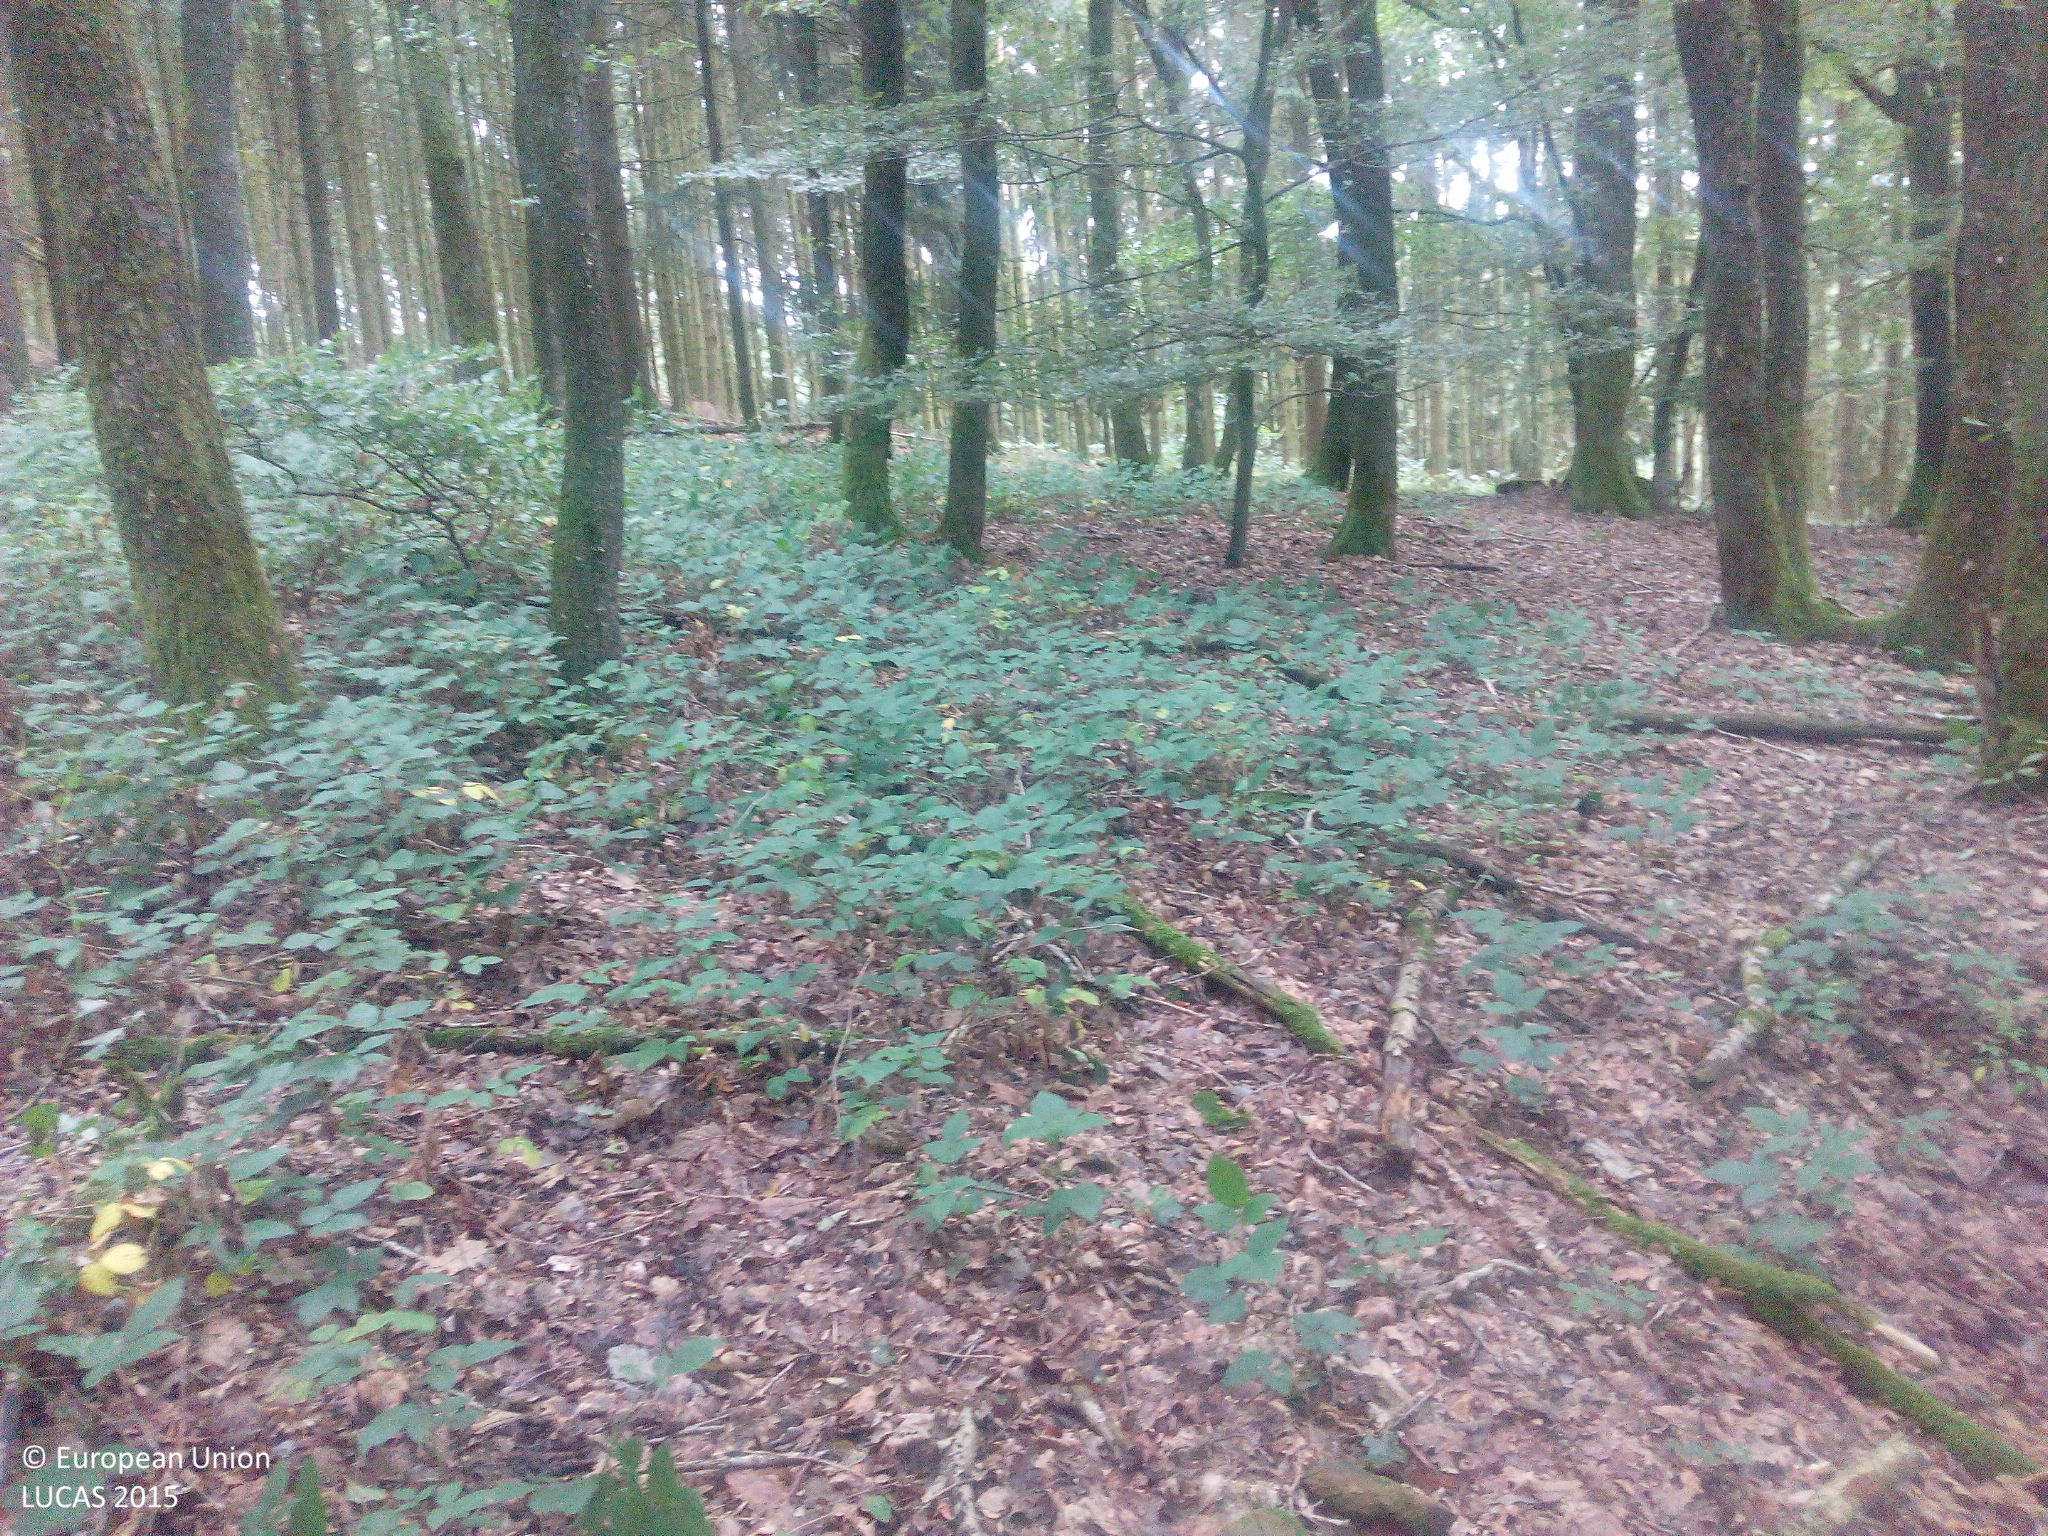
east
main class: Woodland
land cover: Broadleaved woodland
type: mesophytic deciduous forest
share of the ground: > 75 %
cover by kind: broadleaved forest trees 100 %
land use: Forestry
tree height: > 5 m
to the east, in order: Broadleaved woodland; Tracks; Spruce dominated coniferous woodland; Grassland without tree/shrub cover; Spruce dominated coniferous woodland; Grassland without tree/shrub cover; Tracks; Spruce dominated coniferous woodland
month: August
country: DE
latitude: 50.1779
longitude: 6.2886
